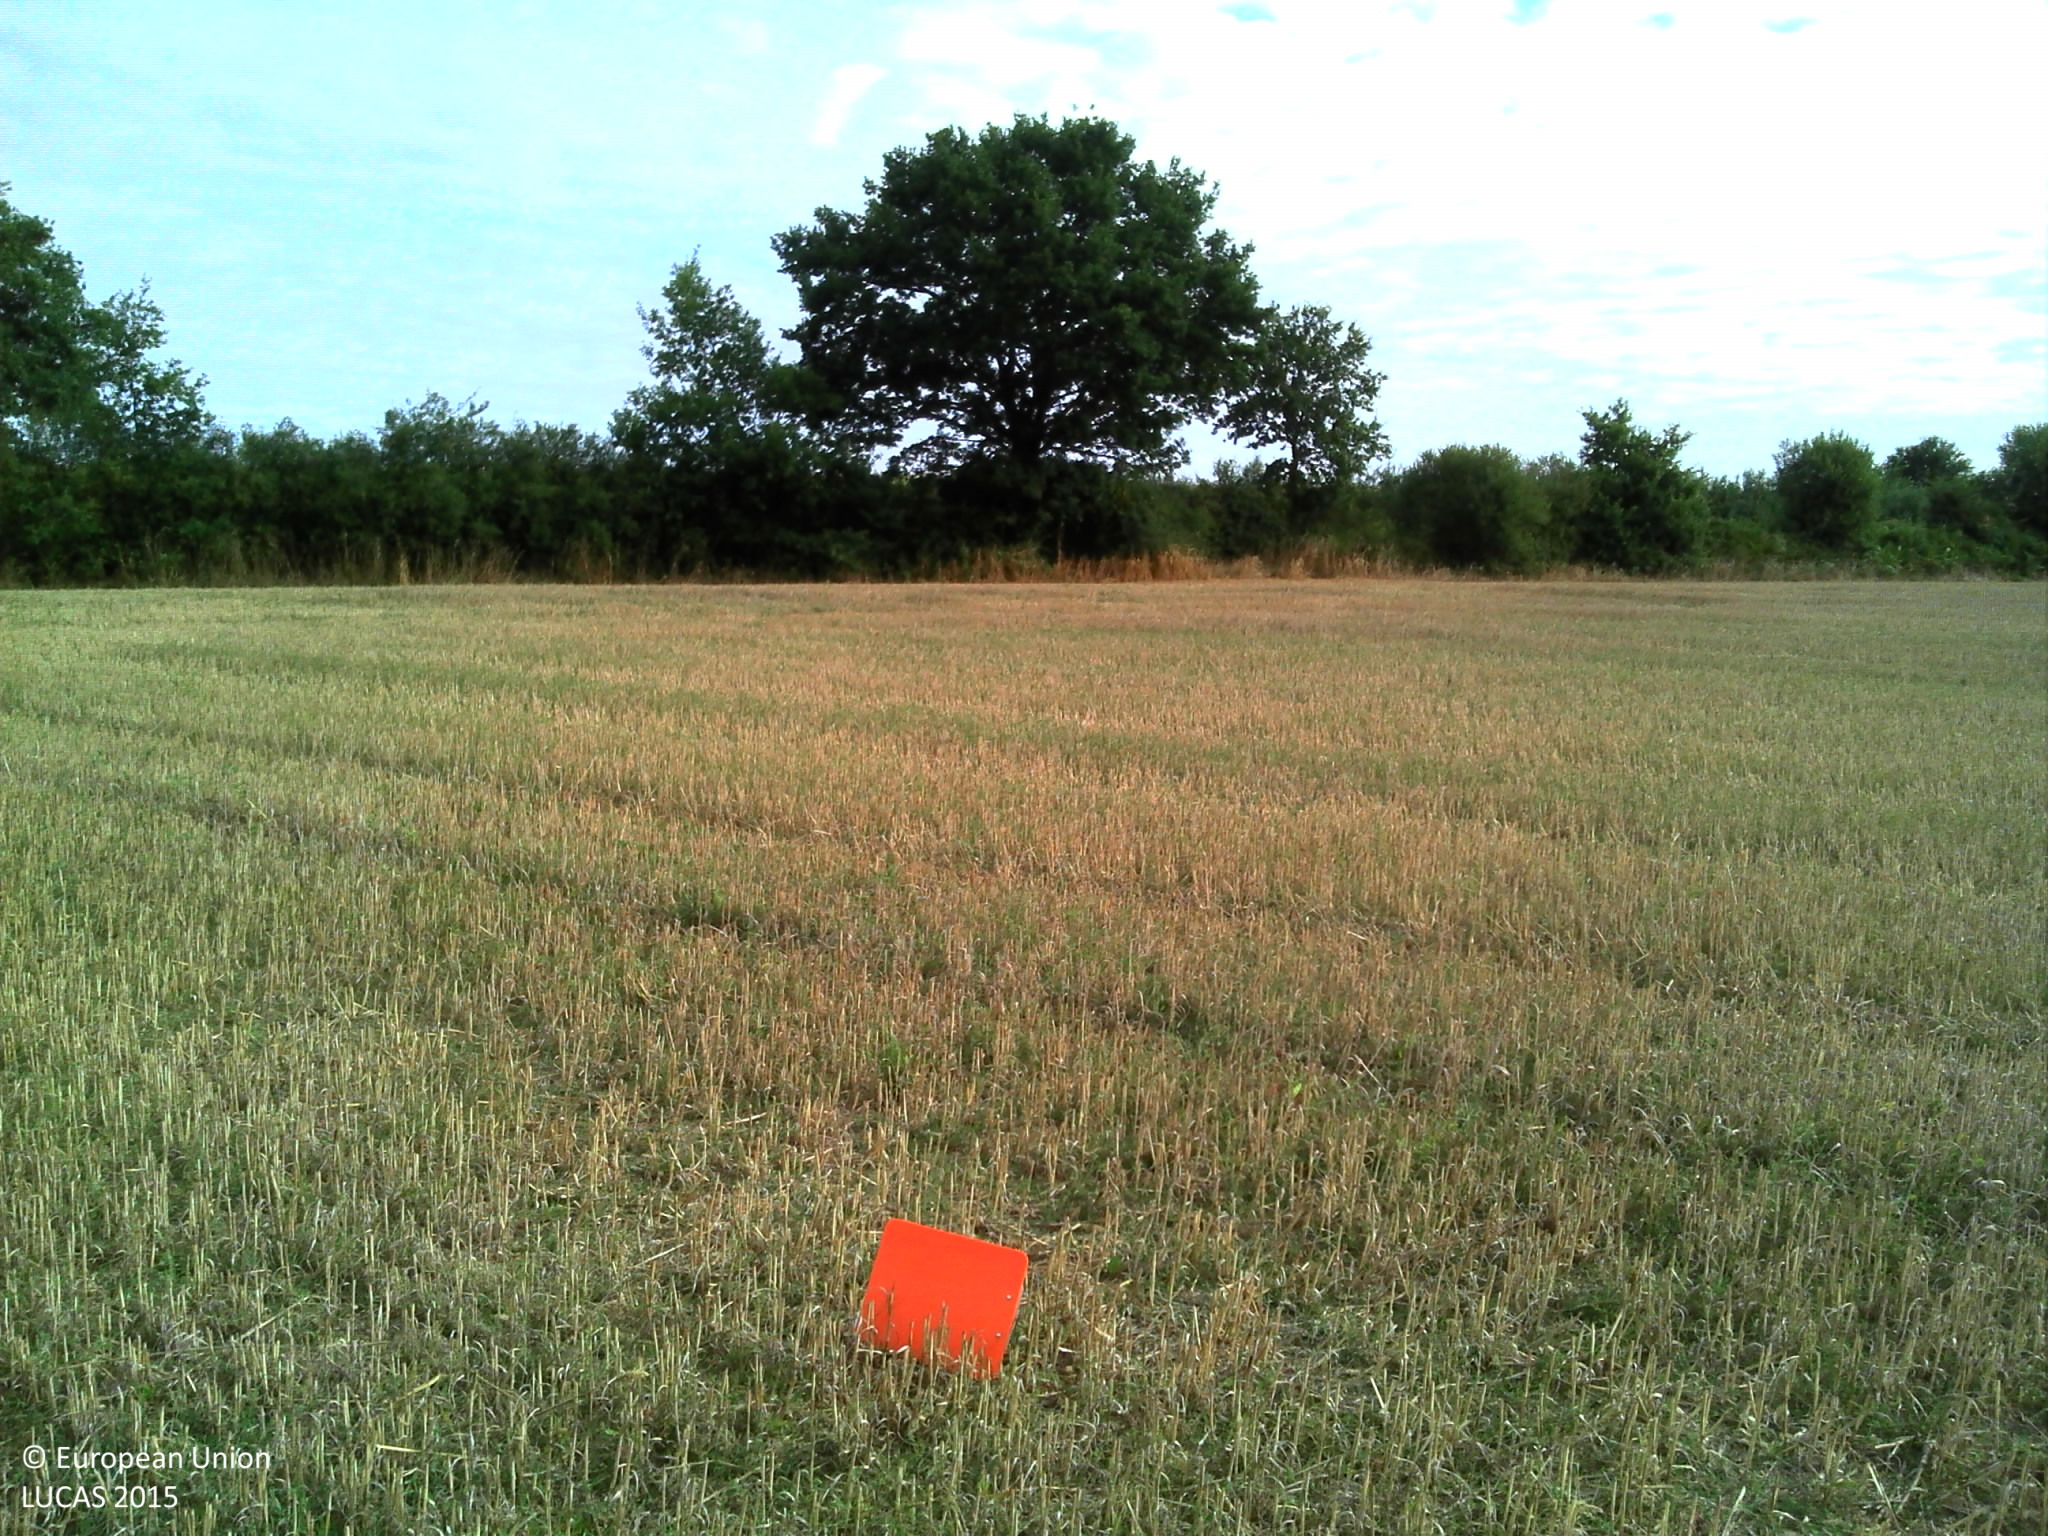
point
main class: Cropland
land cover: Common wheat
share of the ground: > 75 %
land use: Agriculture (excluding fallow land and kitchen gardens)
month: August
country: FR
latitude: 47.0225
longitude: -1.4733
